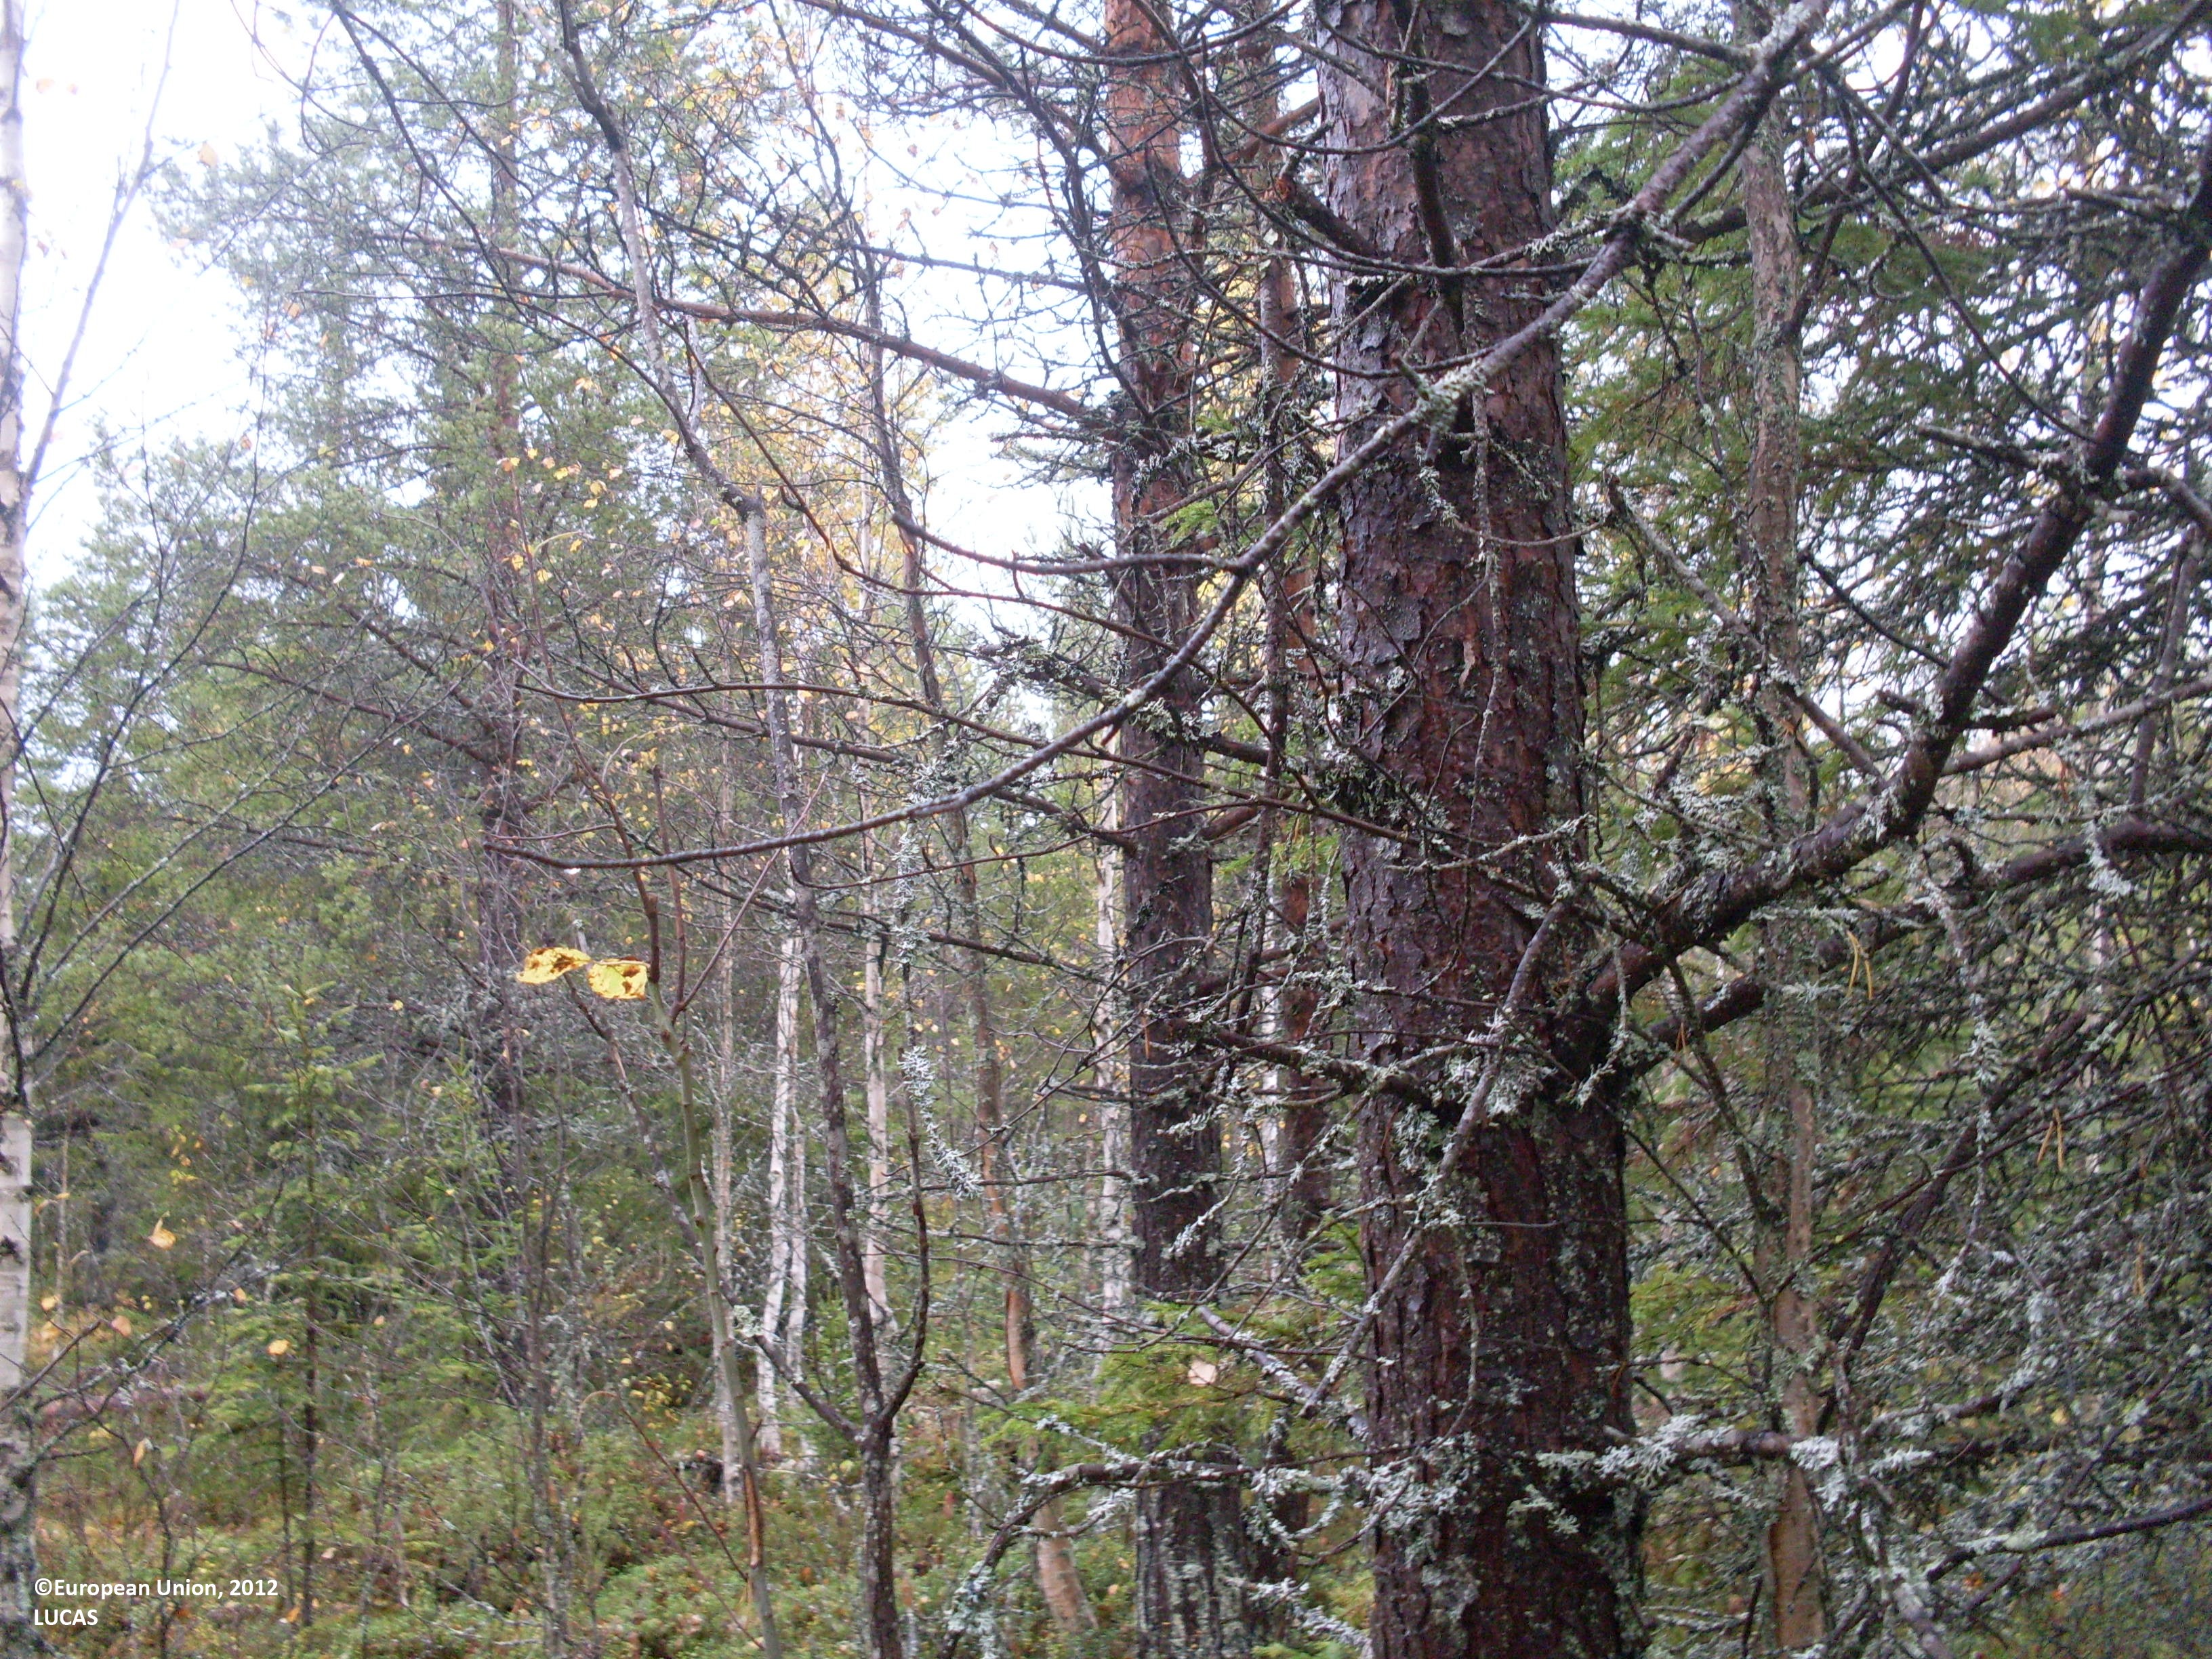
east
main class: Woodland
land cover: Spruce dominated mixed woodland
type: boreal forest
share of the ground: 50 - 75 %
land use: Forestry
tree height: > 5 m
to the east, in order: Spruce dominated mixed woodland; Pine dominated coniferous woodland
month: September
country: FI
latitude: 64.4348
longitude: 28.6458
